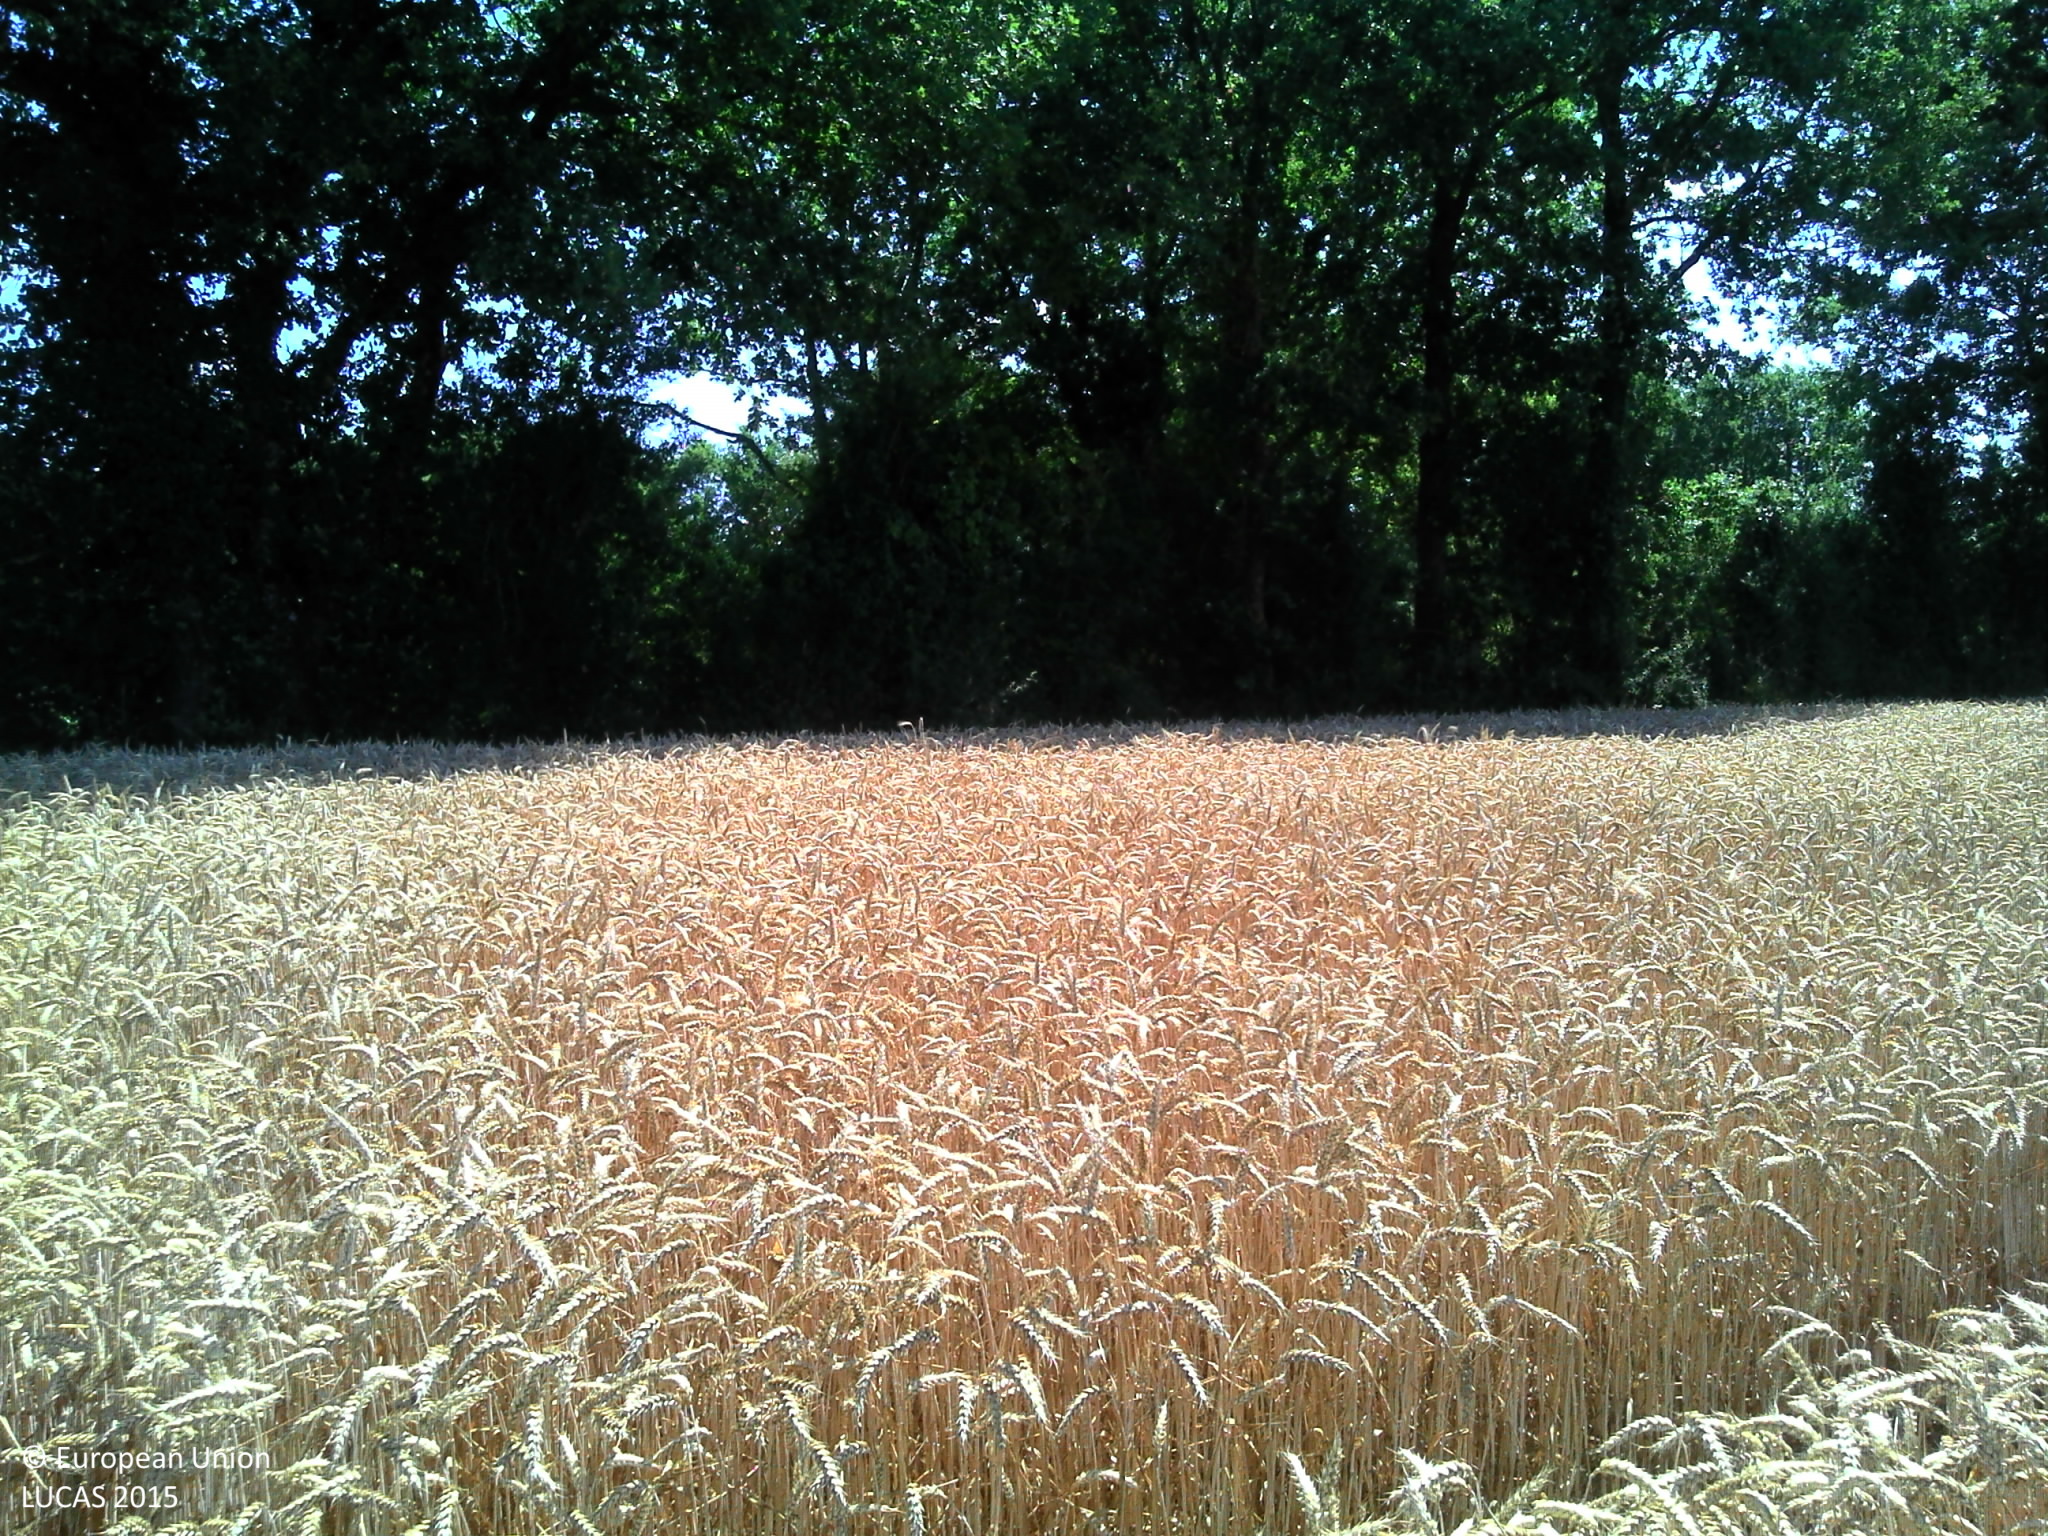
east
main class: Cropland
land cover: Common wheat
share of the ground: > 75 %
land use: Agriculture (excluding fallow land and kitchen gardens)
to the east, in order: Common wheat; Broadleaved woodland; Grass margins; Paved roads, cycling and walking lanes; Grass margins; Ditches and canals; Abandoned hedges; Fences; Grassland without tree/shrub cover; Fences; Lines of trees; Grass margins; Tracks; Grass margins; Lines of trees; Fences; Grassland without tree/shrub cover
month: July
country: FR
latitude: 46.5874
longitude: 0.1781
